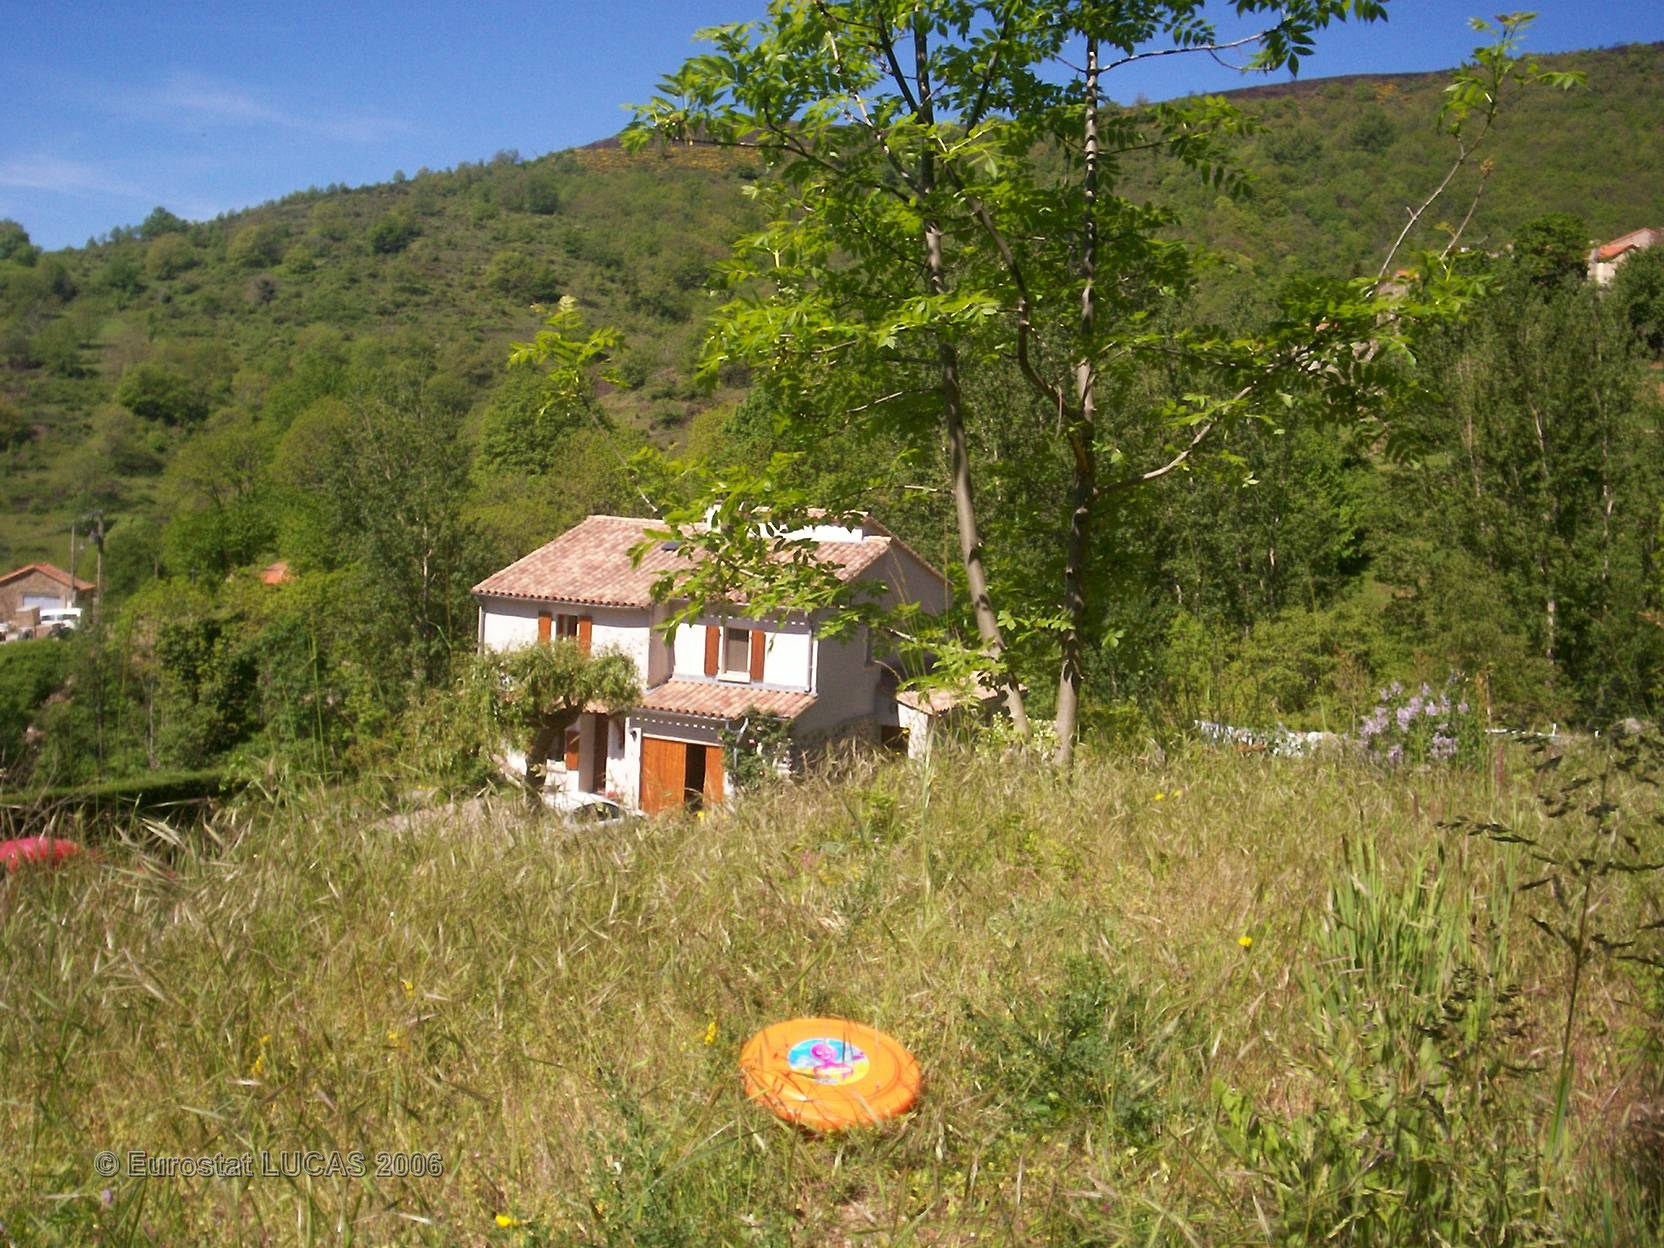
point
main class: Grassland
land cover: Grassland with sparse tree/shrub cover
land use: Residential
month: May
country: FR
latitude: 44.0010
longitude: 3.4848
